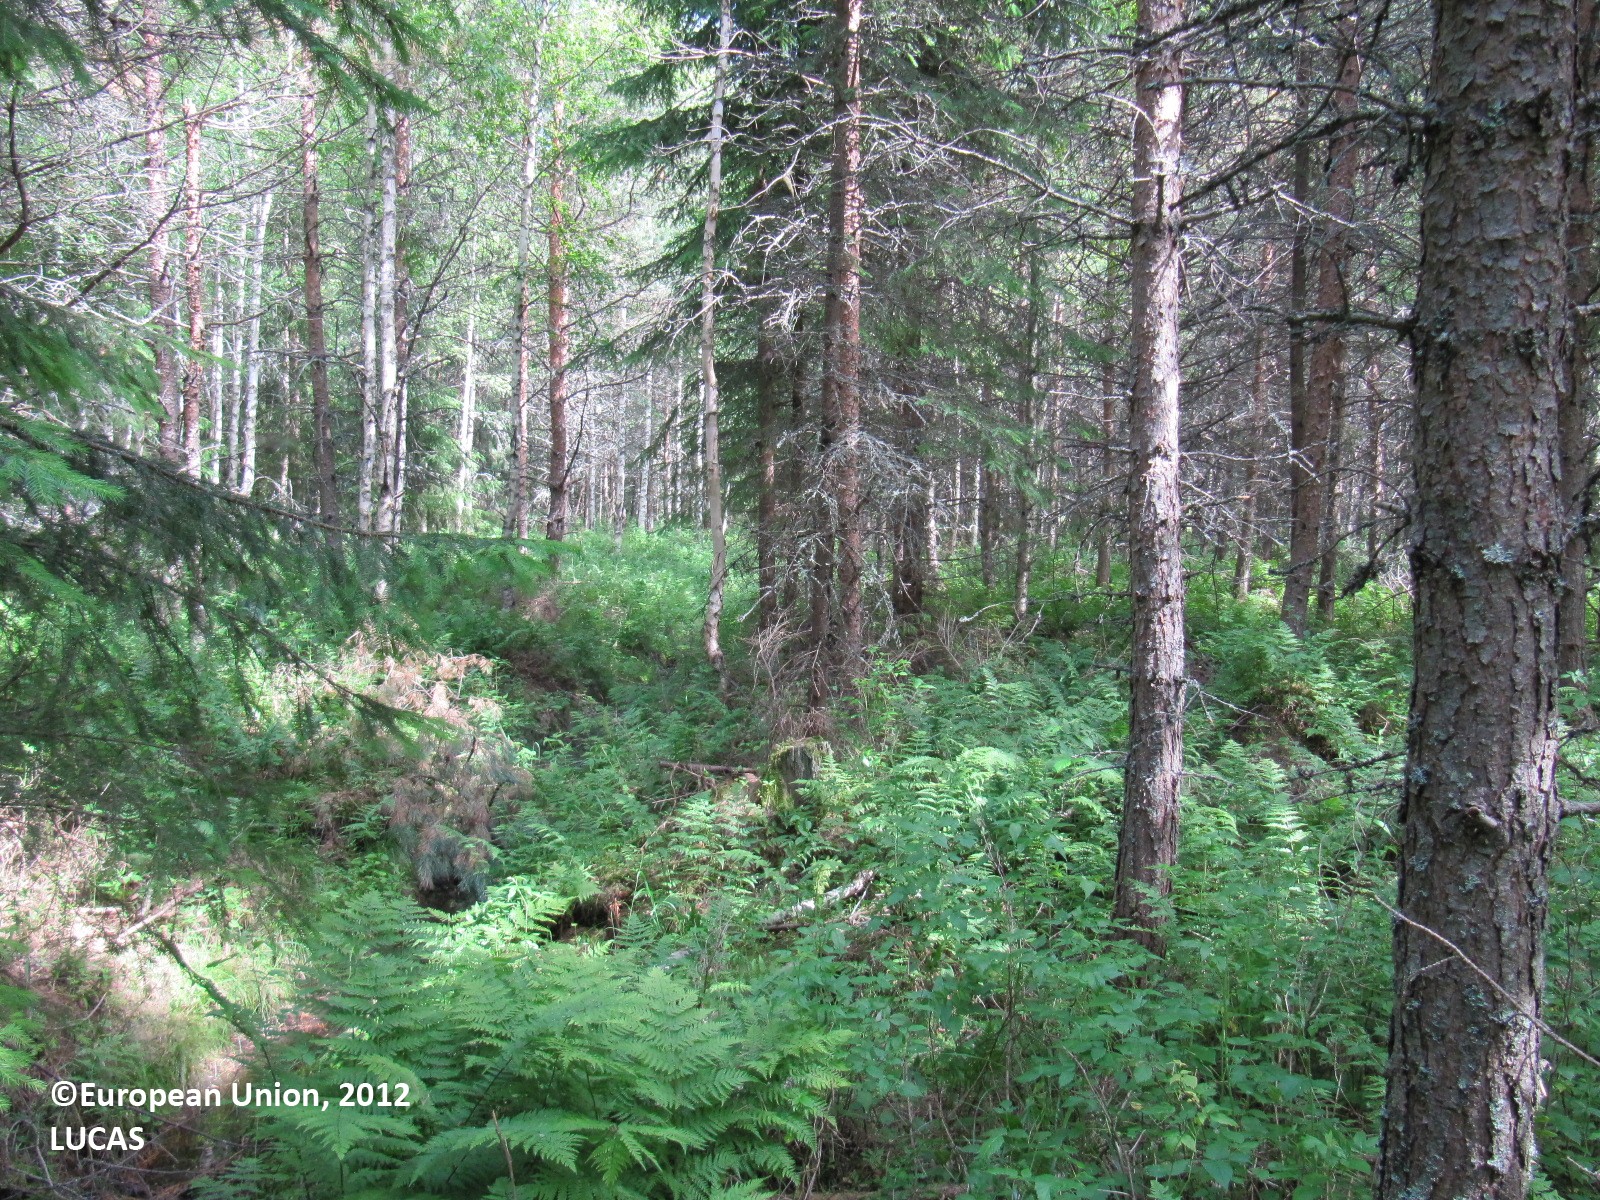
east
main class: Woodland
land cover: Spruce dominated mixed woodland
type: boreal forest
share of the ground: > 75 %
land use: Forestry
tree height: > 5 m
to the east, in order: Spruce dominated mixed woodland; Pine dominated mixed woodland; Other coniferous woodland
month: July
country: FI
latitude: 60.8806
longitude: 23.3262
